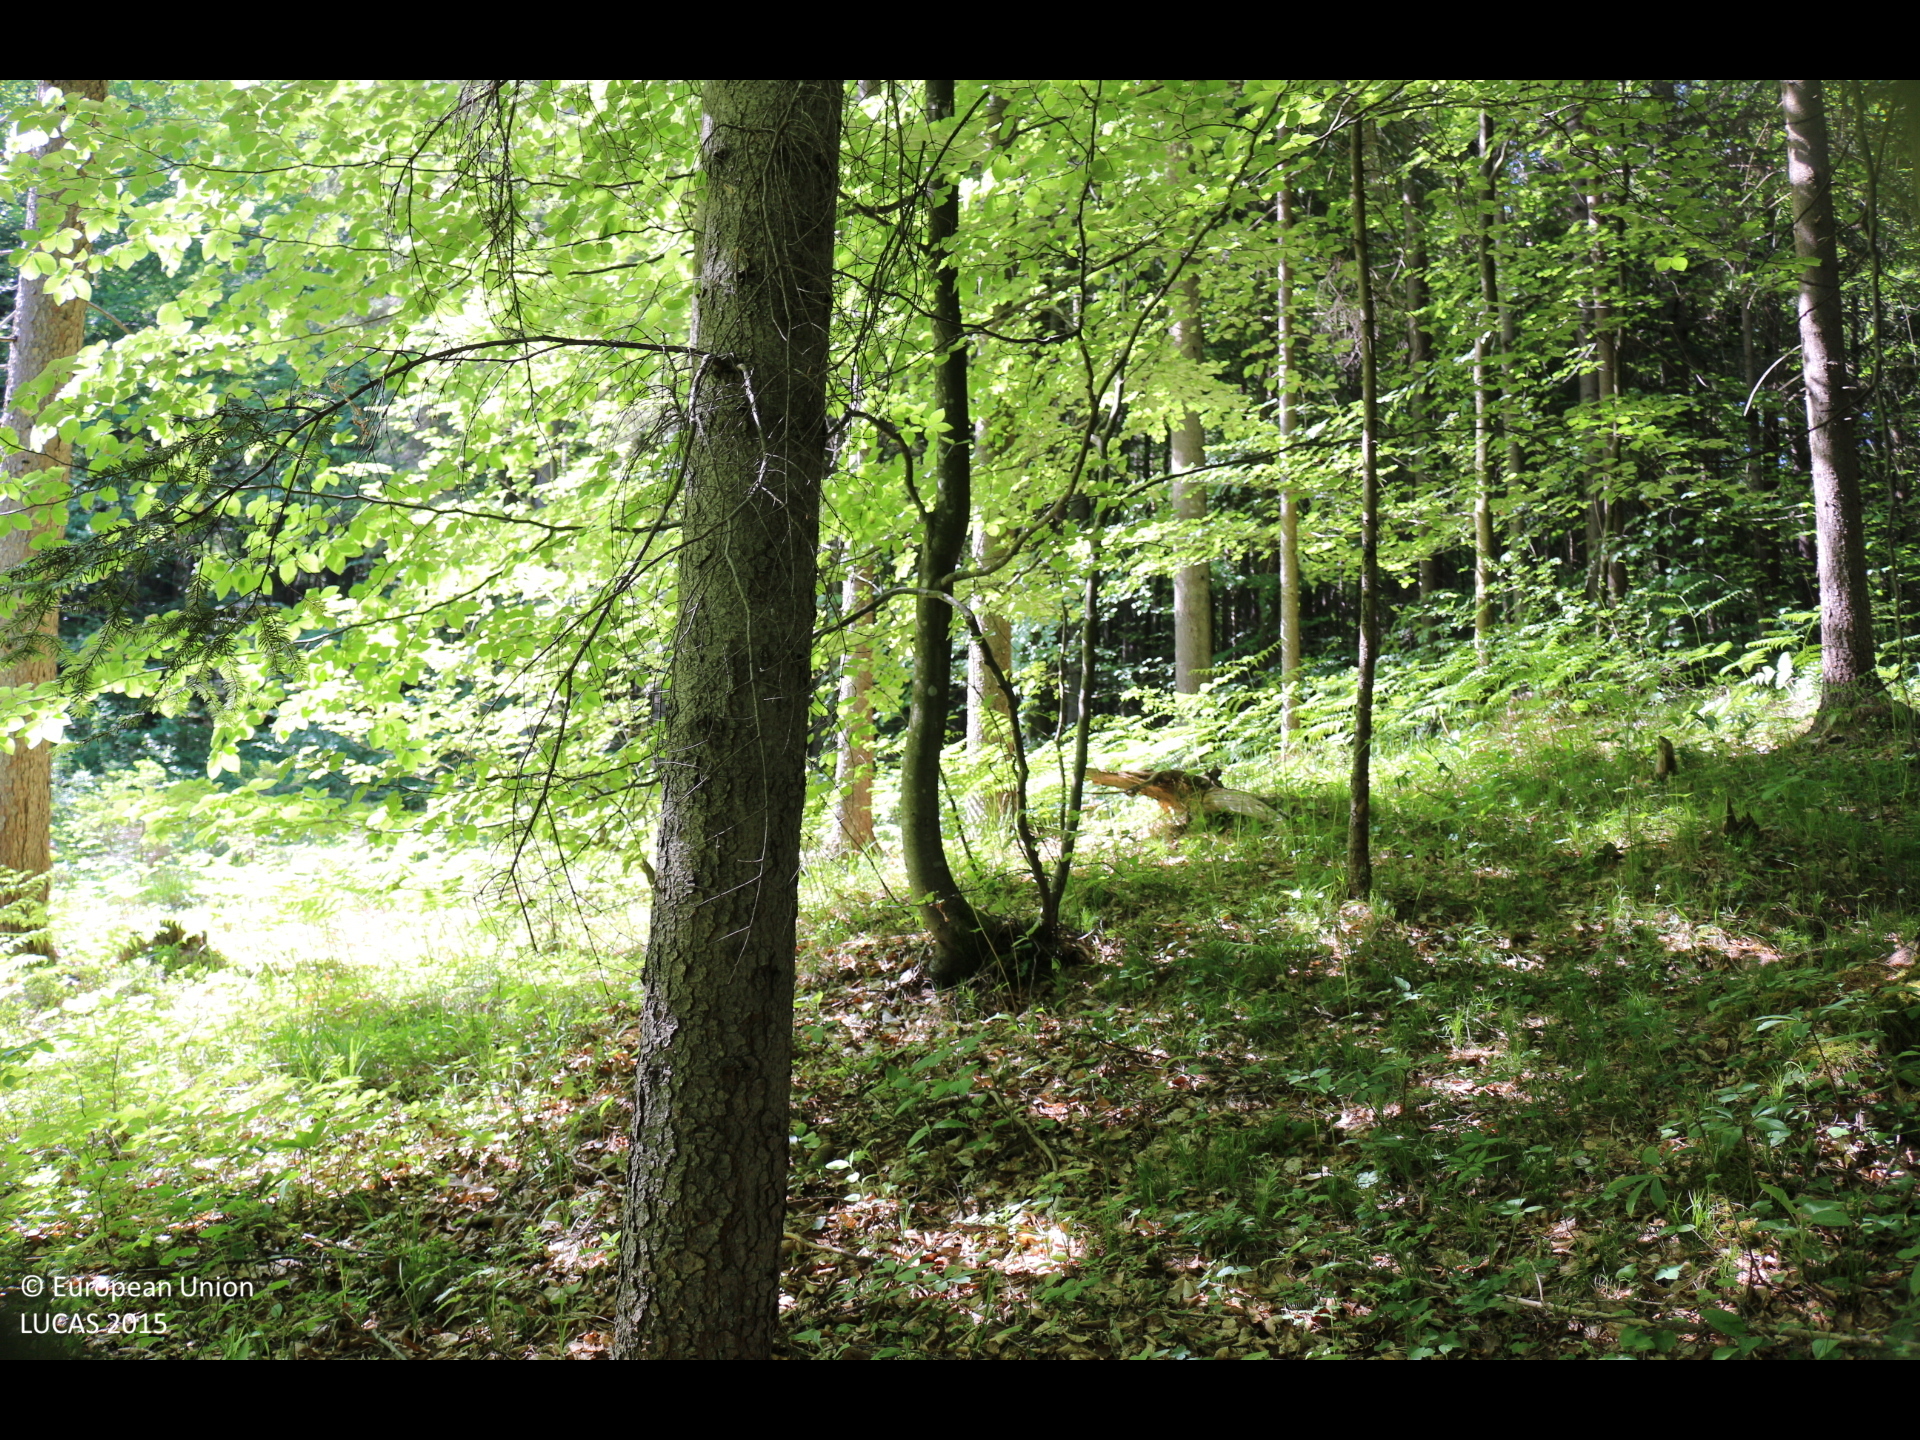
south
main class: Woodland
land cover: Spruce dominated mixed woodland
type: mountainous beech forest
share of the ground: > 75 %
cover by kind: coniferous forest trees 60 %, broadleaved forest trees 40 %
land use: Forestry
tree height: > 5 m
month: May
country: AT
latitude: 46.5168
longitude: 14.3116
